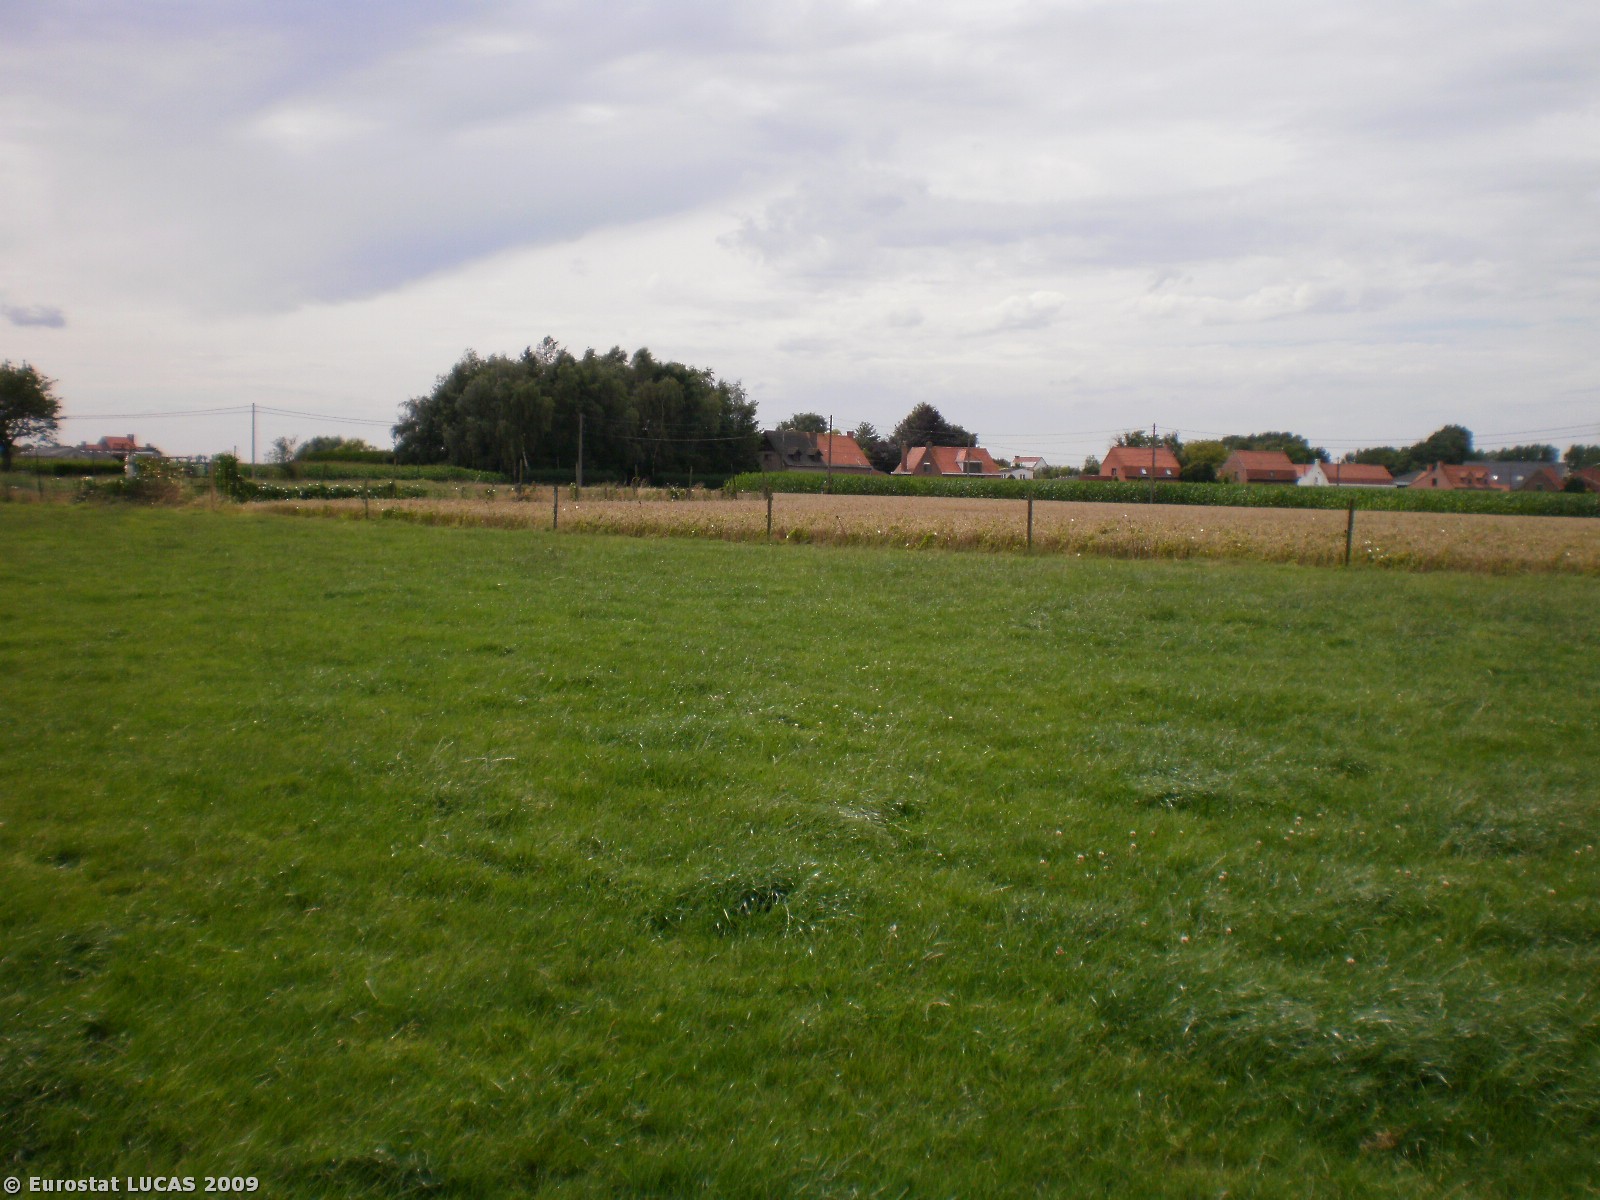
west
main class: Grassland
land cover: Grassland without tree/shrub cover
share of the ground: > 75 %
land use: Agriculture (excluding fallow land and kitchen gardens)
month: July
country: BE
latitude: 50.8583
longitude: 2.7862
